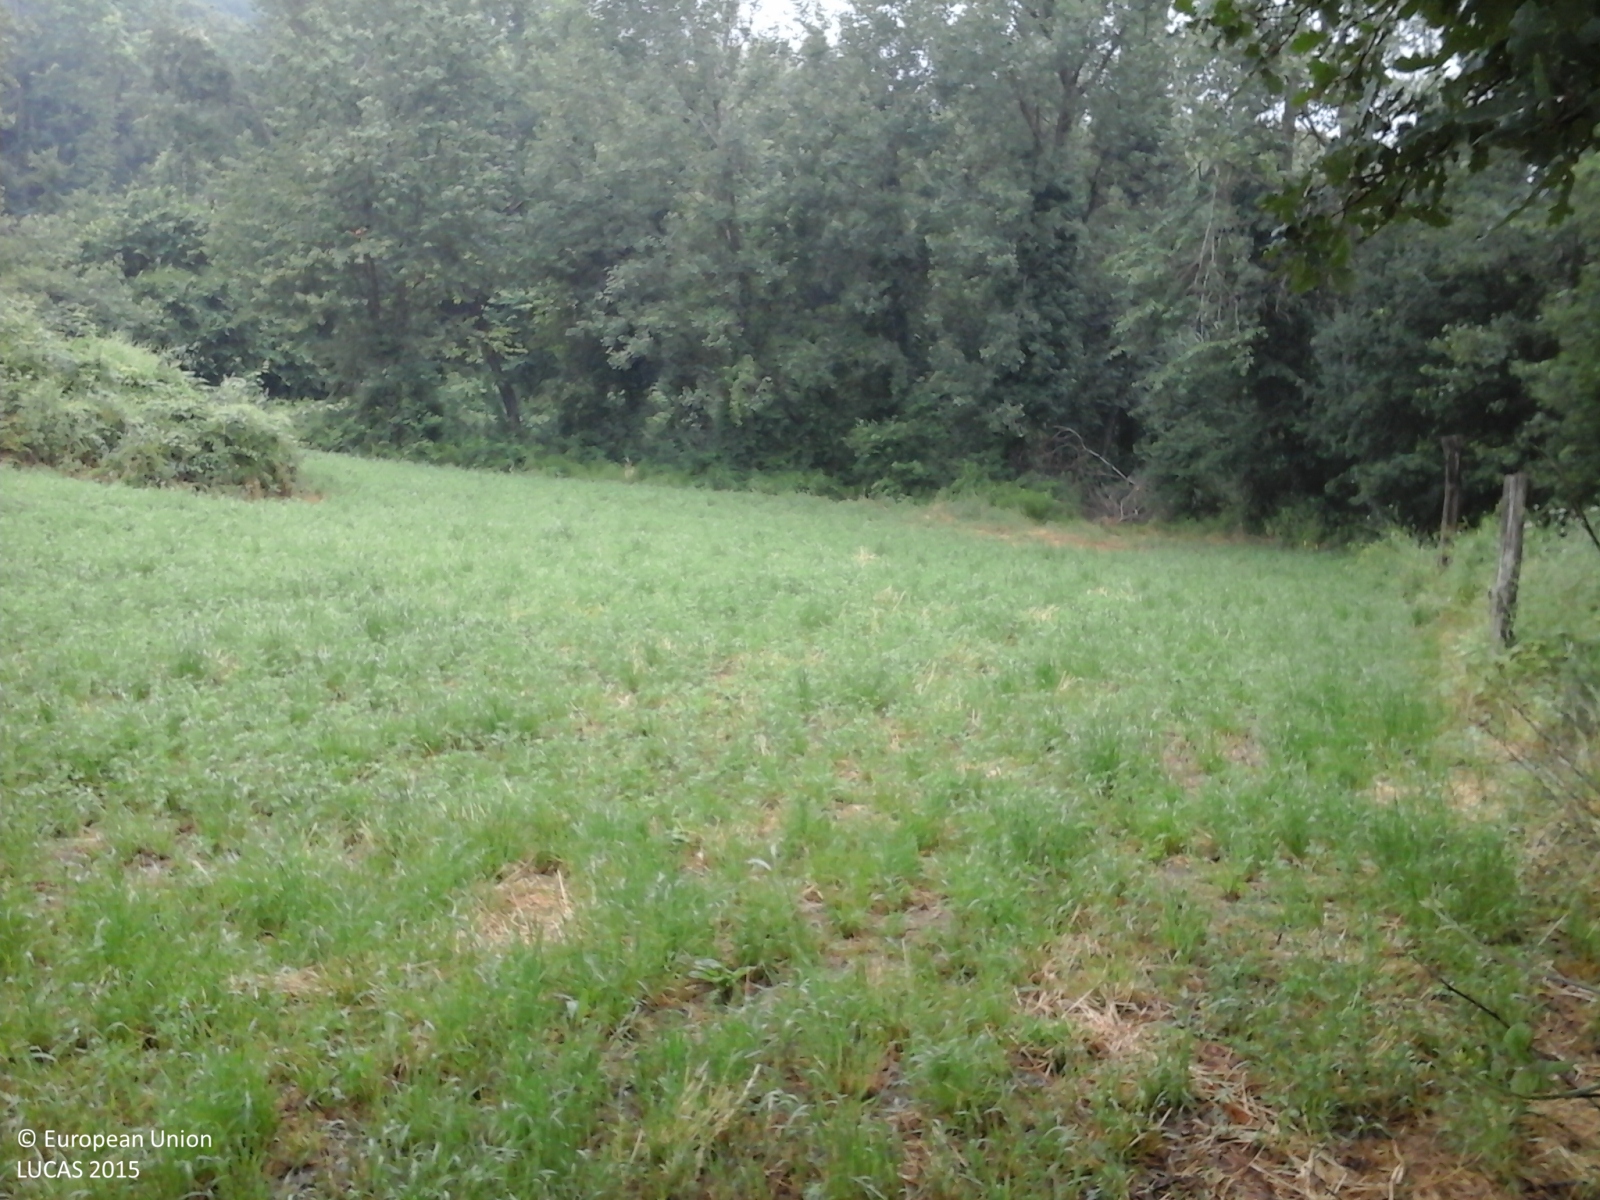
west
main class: Woodland
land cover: Broadleaved woodland
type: thermophilous deciduous forest
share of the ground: > 75 %
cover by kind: broadleaved forest trees 90 %, shrubs 10 %
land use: Forestry
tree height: > 5 m
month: June
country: IT
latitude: 44.3285
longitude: 10.9133
